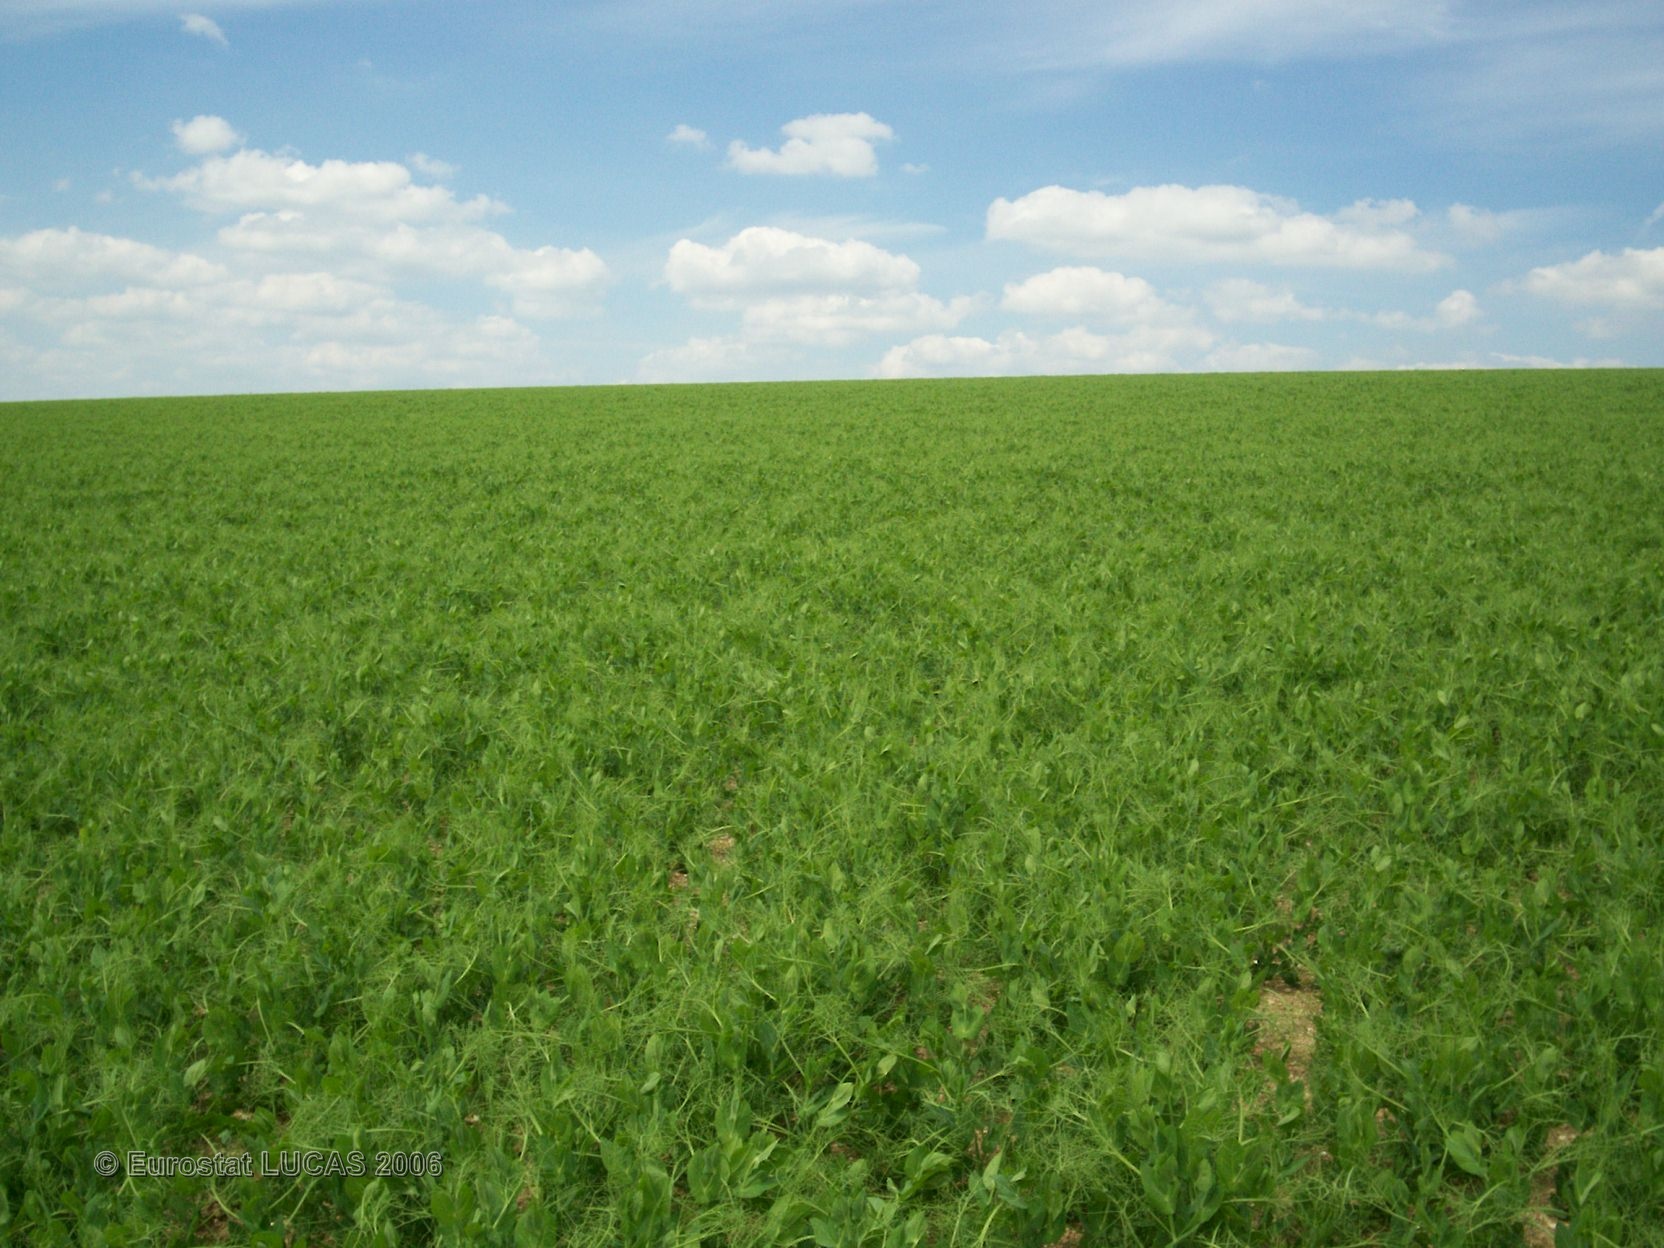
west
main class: Cropland
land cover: Dry pulses
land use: Agriculture (excluding fallow land and kitchen gardens)
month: June
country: FR
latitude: 48.8493
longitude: 4.6142
